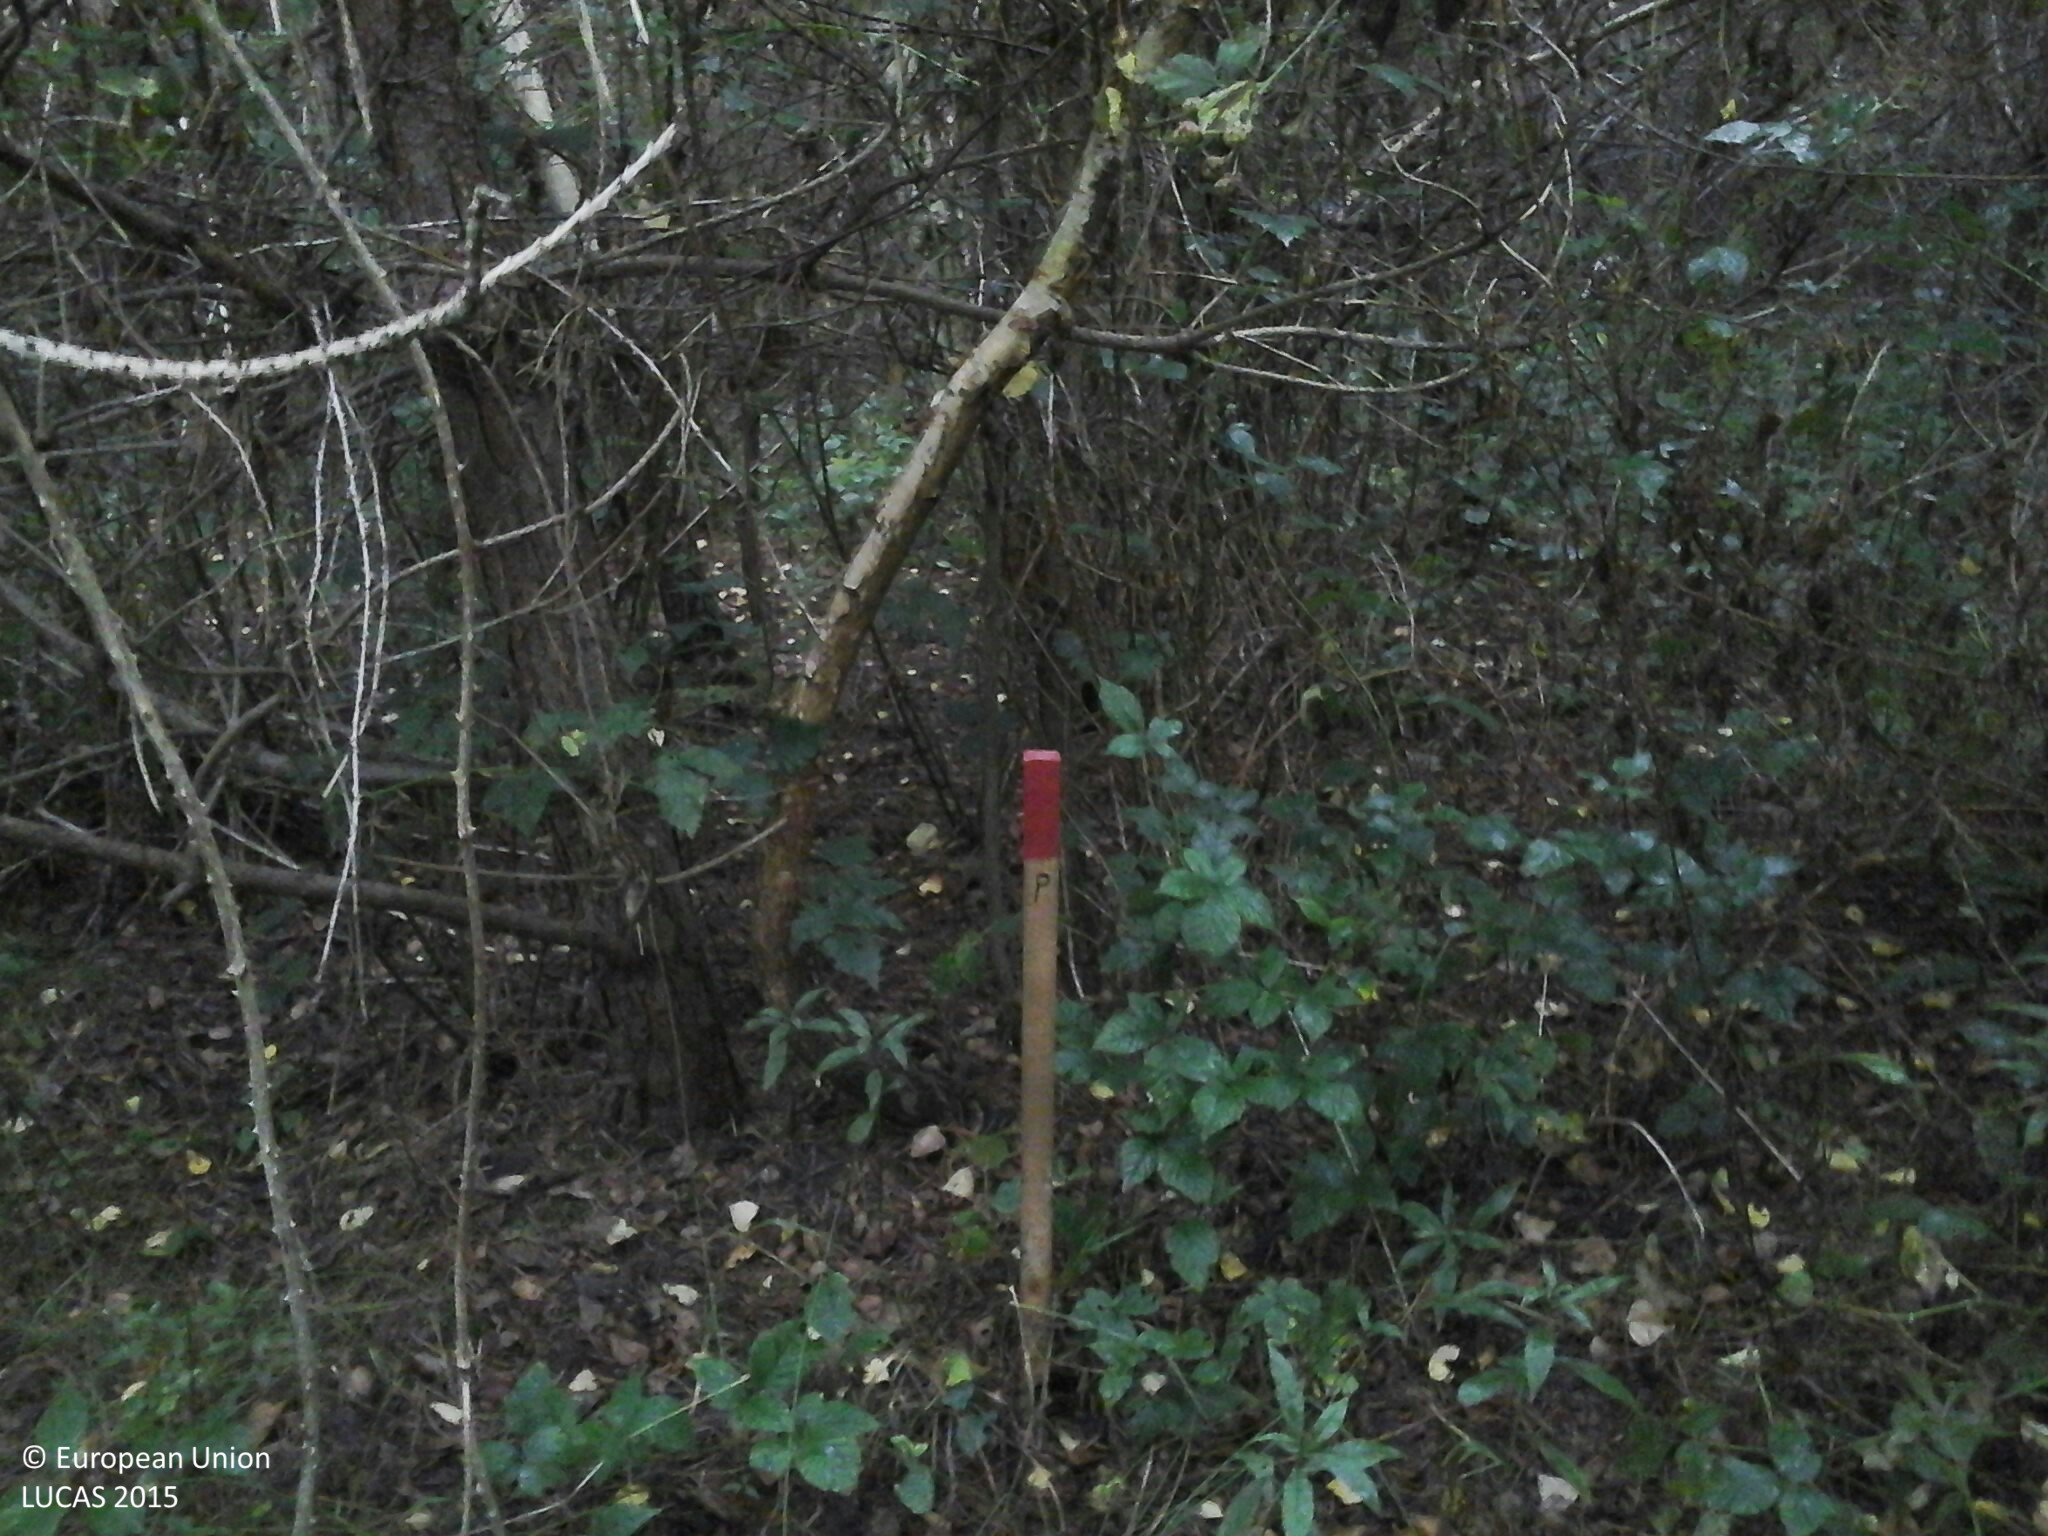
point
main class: Woodland
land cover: Pine dominated coniferous woodland
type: hemiboreal forest and nemoral coniferous forest and mixed broadleaved-coniferous forest
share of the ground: 50 - 75 %
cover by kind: coniferous forest trees 55 %, shrubs 20 %, broadleaved forest trees 15 %, herbaceous plants 10 %
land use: Forestry
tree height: < 5 m
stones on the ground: < 10 %
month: July
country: HU
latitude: 46.7866
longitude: 16.4860
